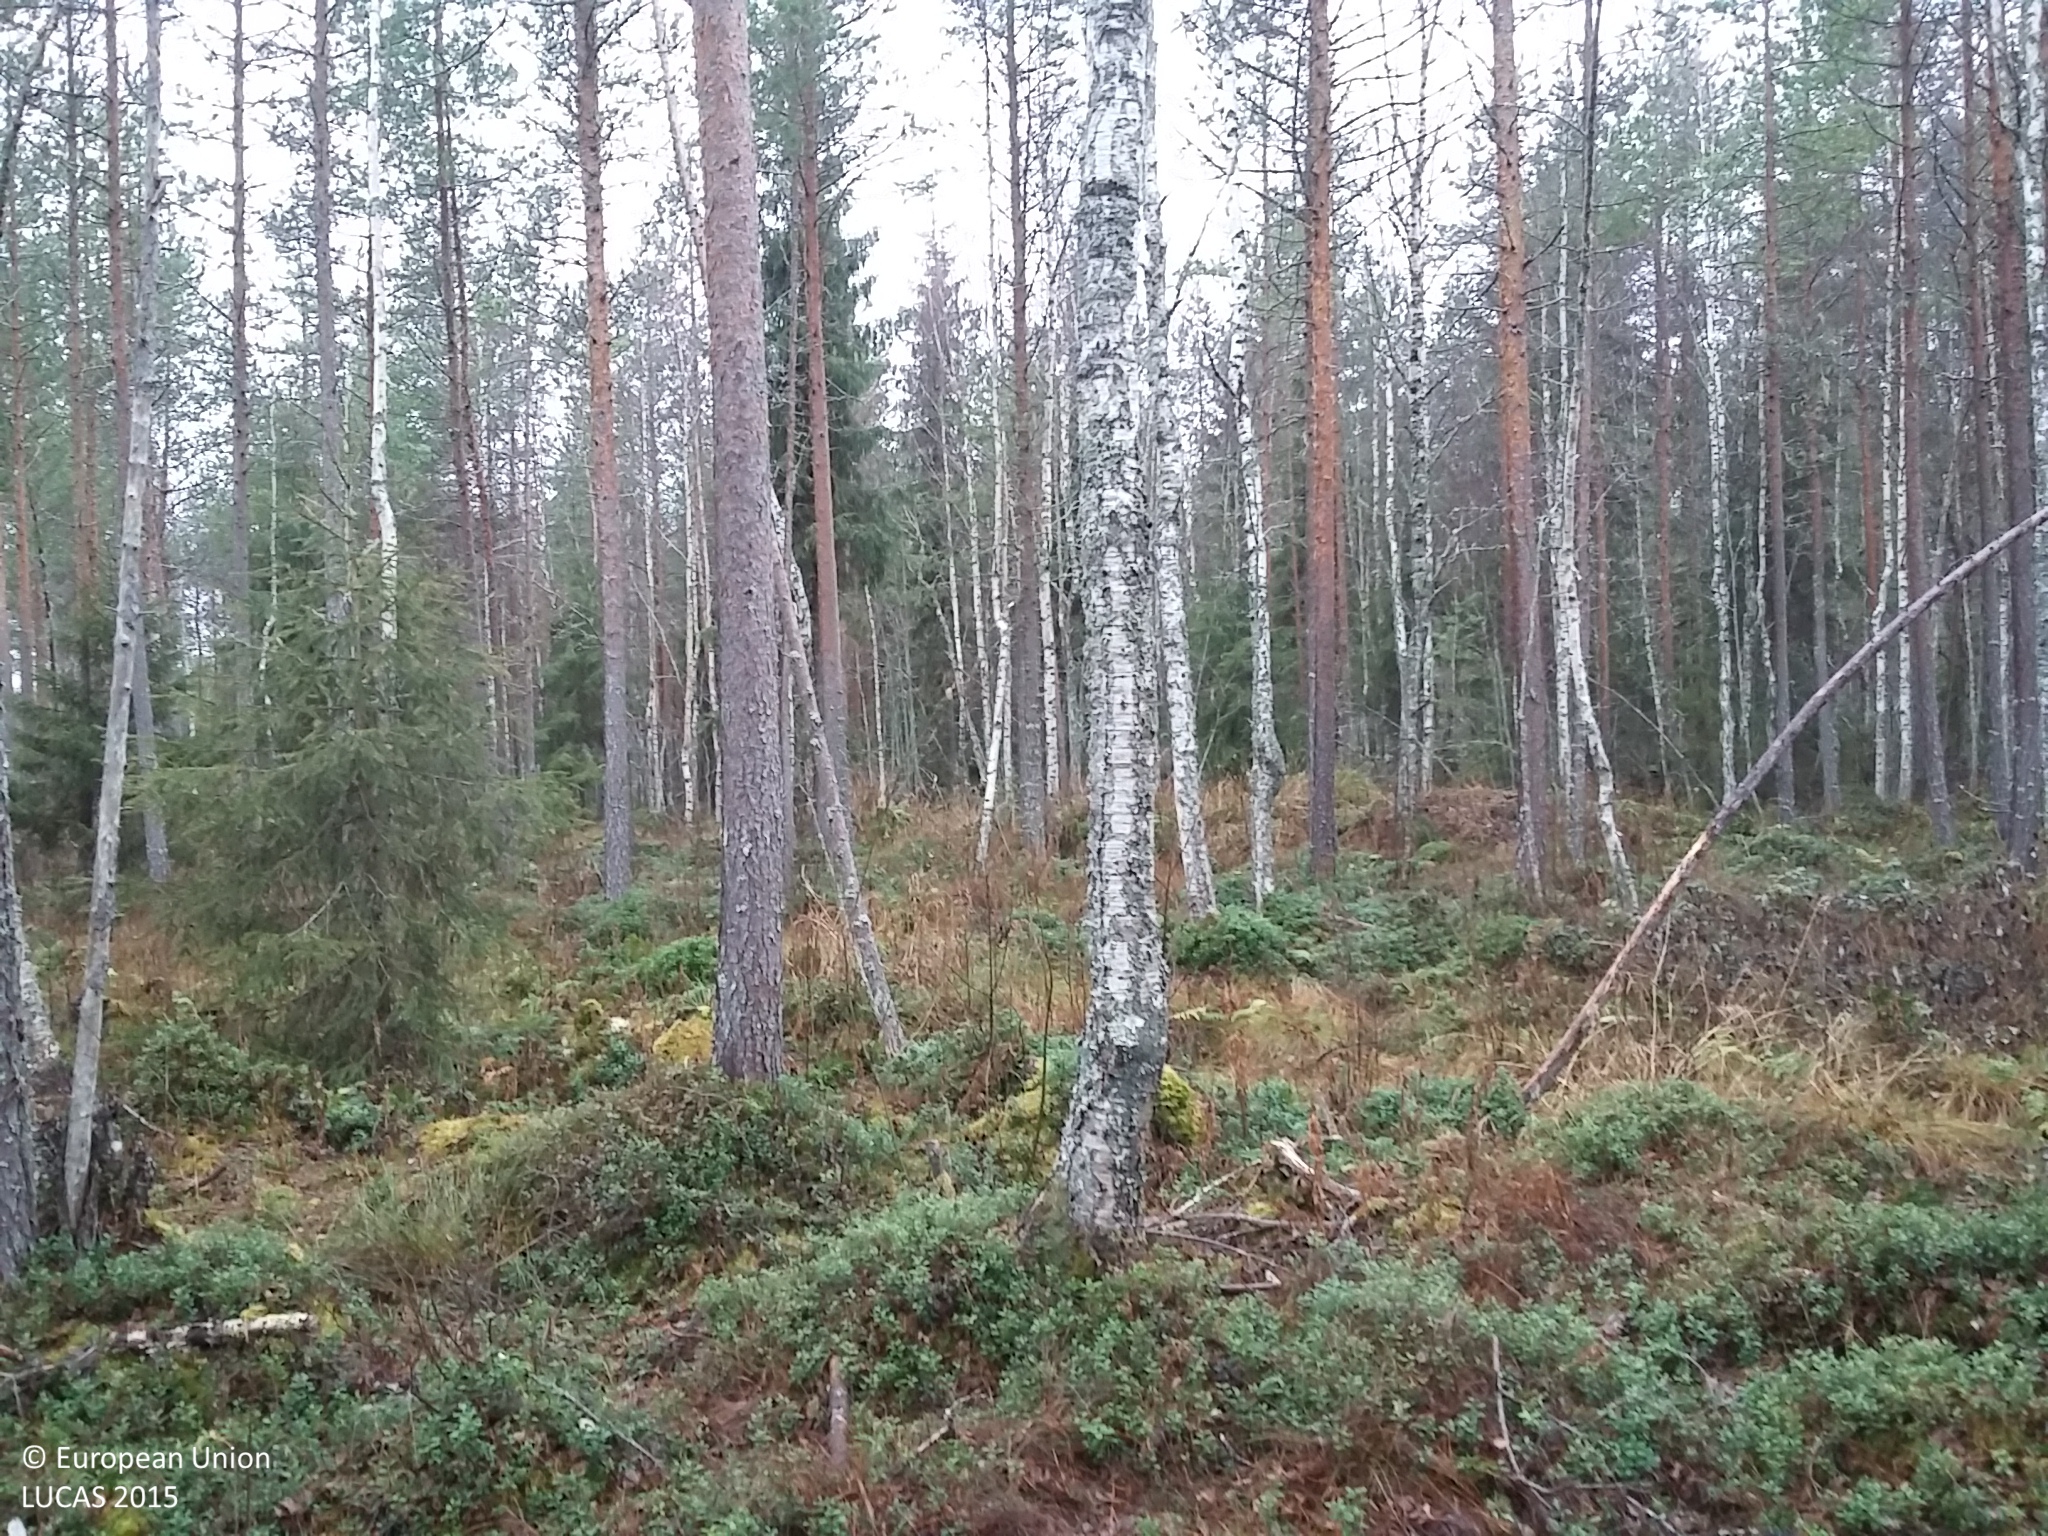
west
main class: Woodland
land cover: Pine dominated coniferous woodland
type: boreal forest
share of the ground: > 75 %
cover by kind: coniferous forest trees 65 %, broadleaved forest trees 10 %, shrubs 10 %, herbaceous plants 10 %, lichens and mosses 5 %
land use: Forestry
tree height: > 5 m
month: October
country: FI
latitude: 64.5266
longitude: 25.4039
